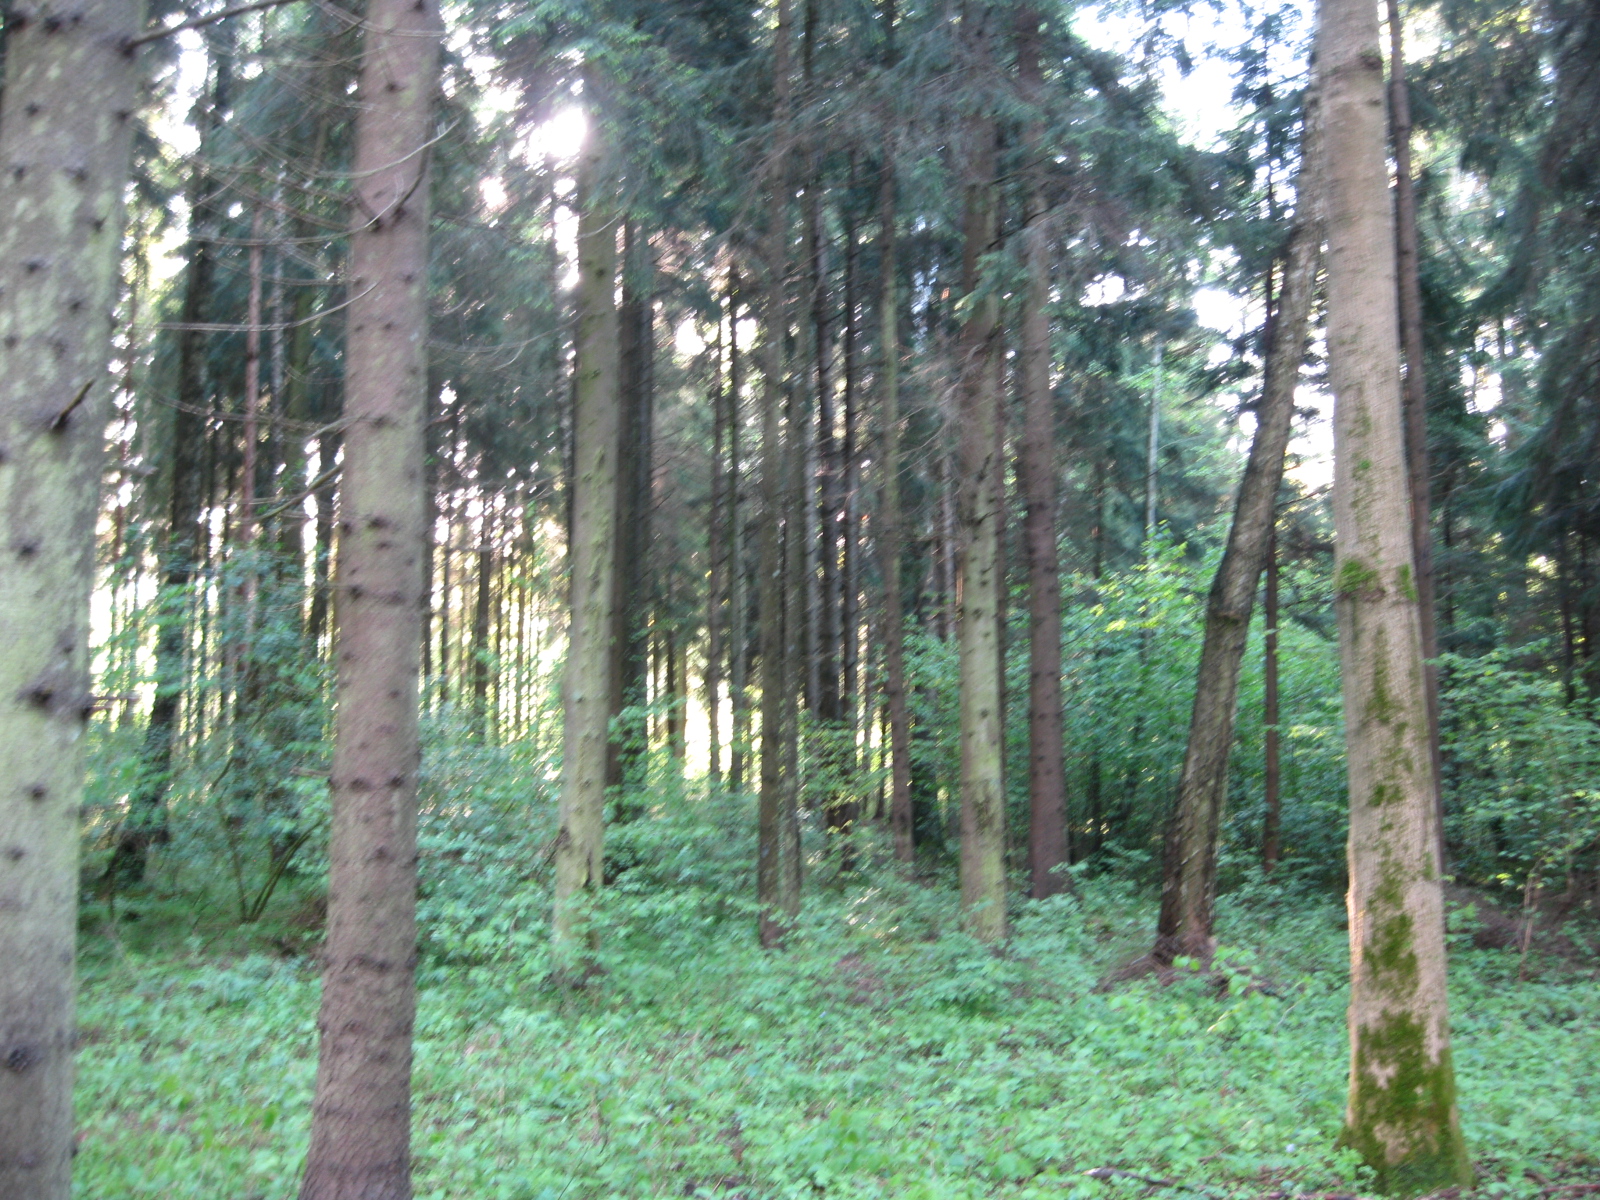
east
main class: Woodland
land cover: Spruce dominated coniferous woodland
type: hemiboreal forest and nemoral coniferous forest and mixed broadleaved-coniferous forest
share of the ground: > 75 %
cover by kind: coniferous forest trees 80 %, herbaceous plants 10 %, broadleaved forest trees 5 %, shrubs 5 %
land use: Forestry
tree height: > 5 m
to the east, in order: Spruce dominated coniferous woodland; Other mixed woodland; Broadleaved woodland
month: May
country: LT
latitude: 56.3280
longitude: 24.0103
